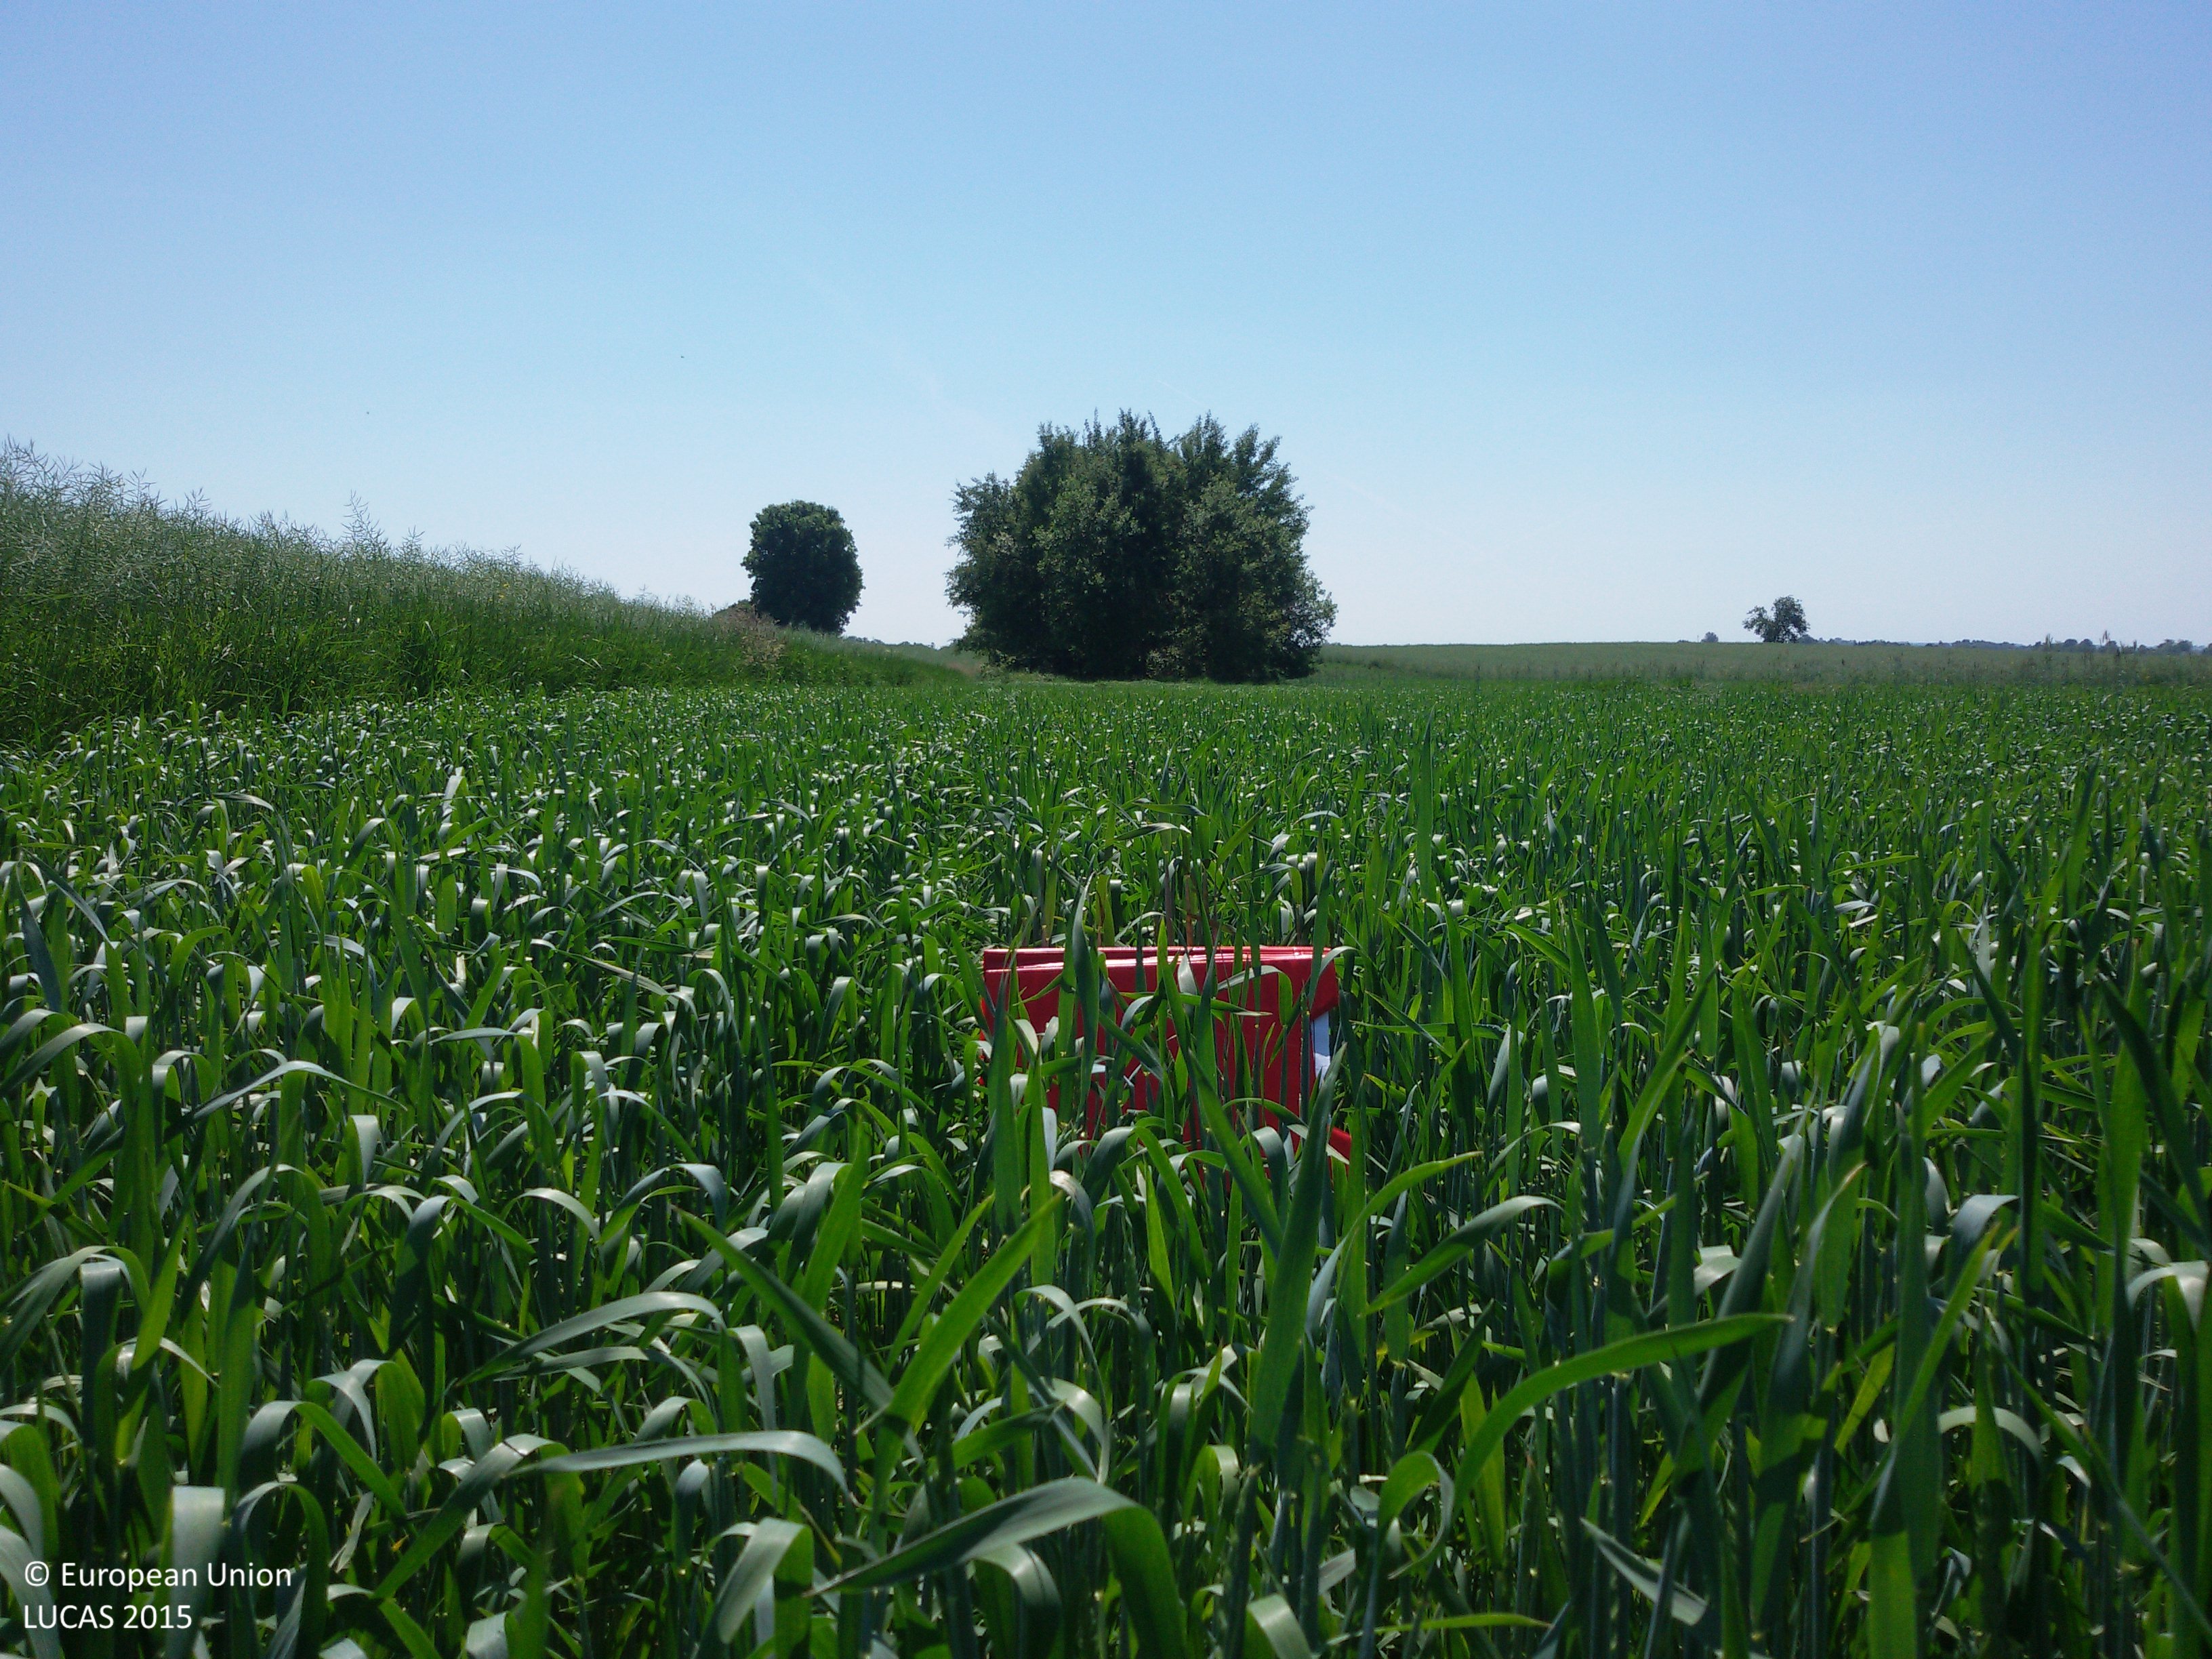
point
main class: Cropland
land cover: Common wheat
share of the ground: > 75 %
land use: Agriculture (excluding fallow land and kitchen gardens)
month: June
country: PL
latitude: 51.2866
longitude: 22.9063
